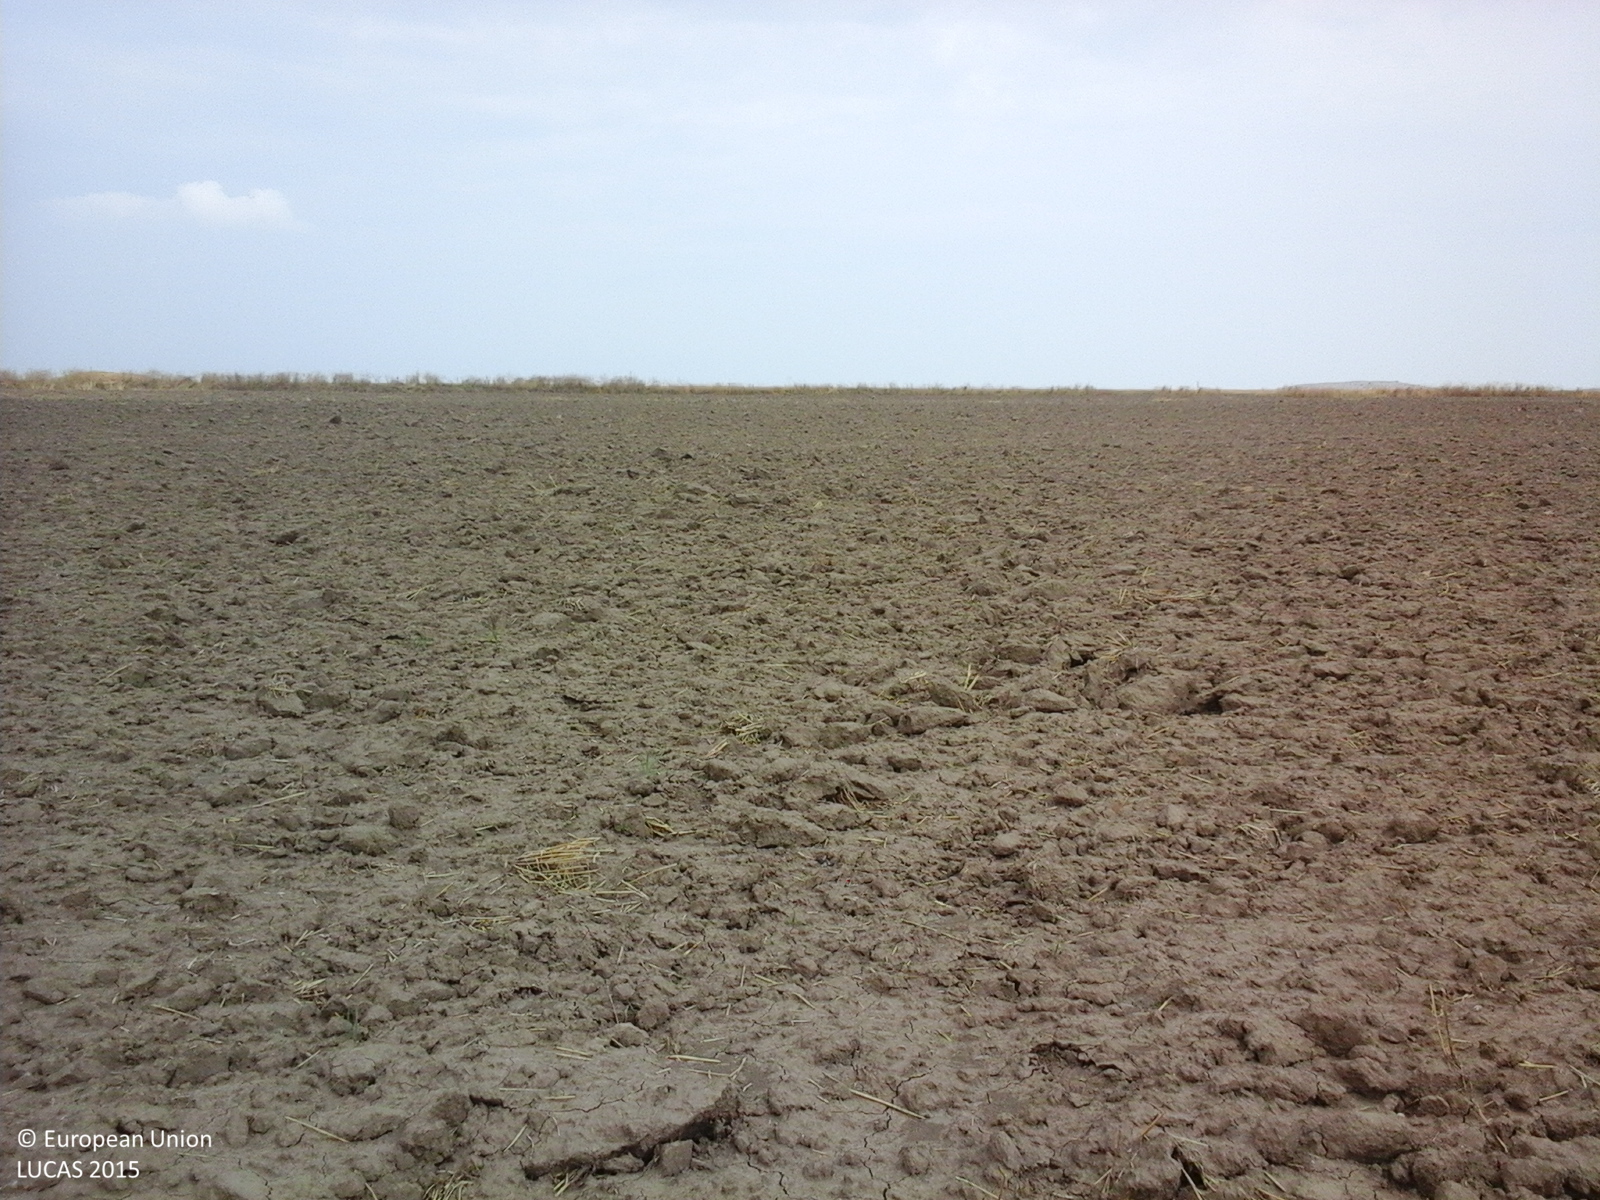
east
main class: Cropland
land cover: Oats
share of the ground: < 10 %
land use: Agriculture (excluding fallow land and kitchen gardens)
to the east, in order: Oats; Tracks; Common wheat
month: July
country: RO
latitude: 45.0241
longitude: 28.6506
